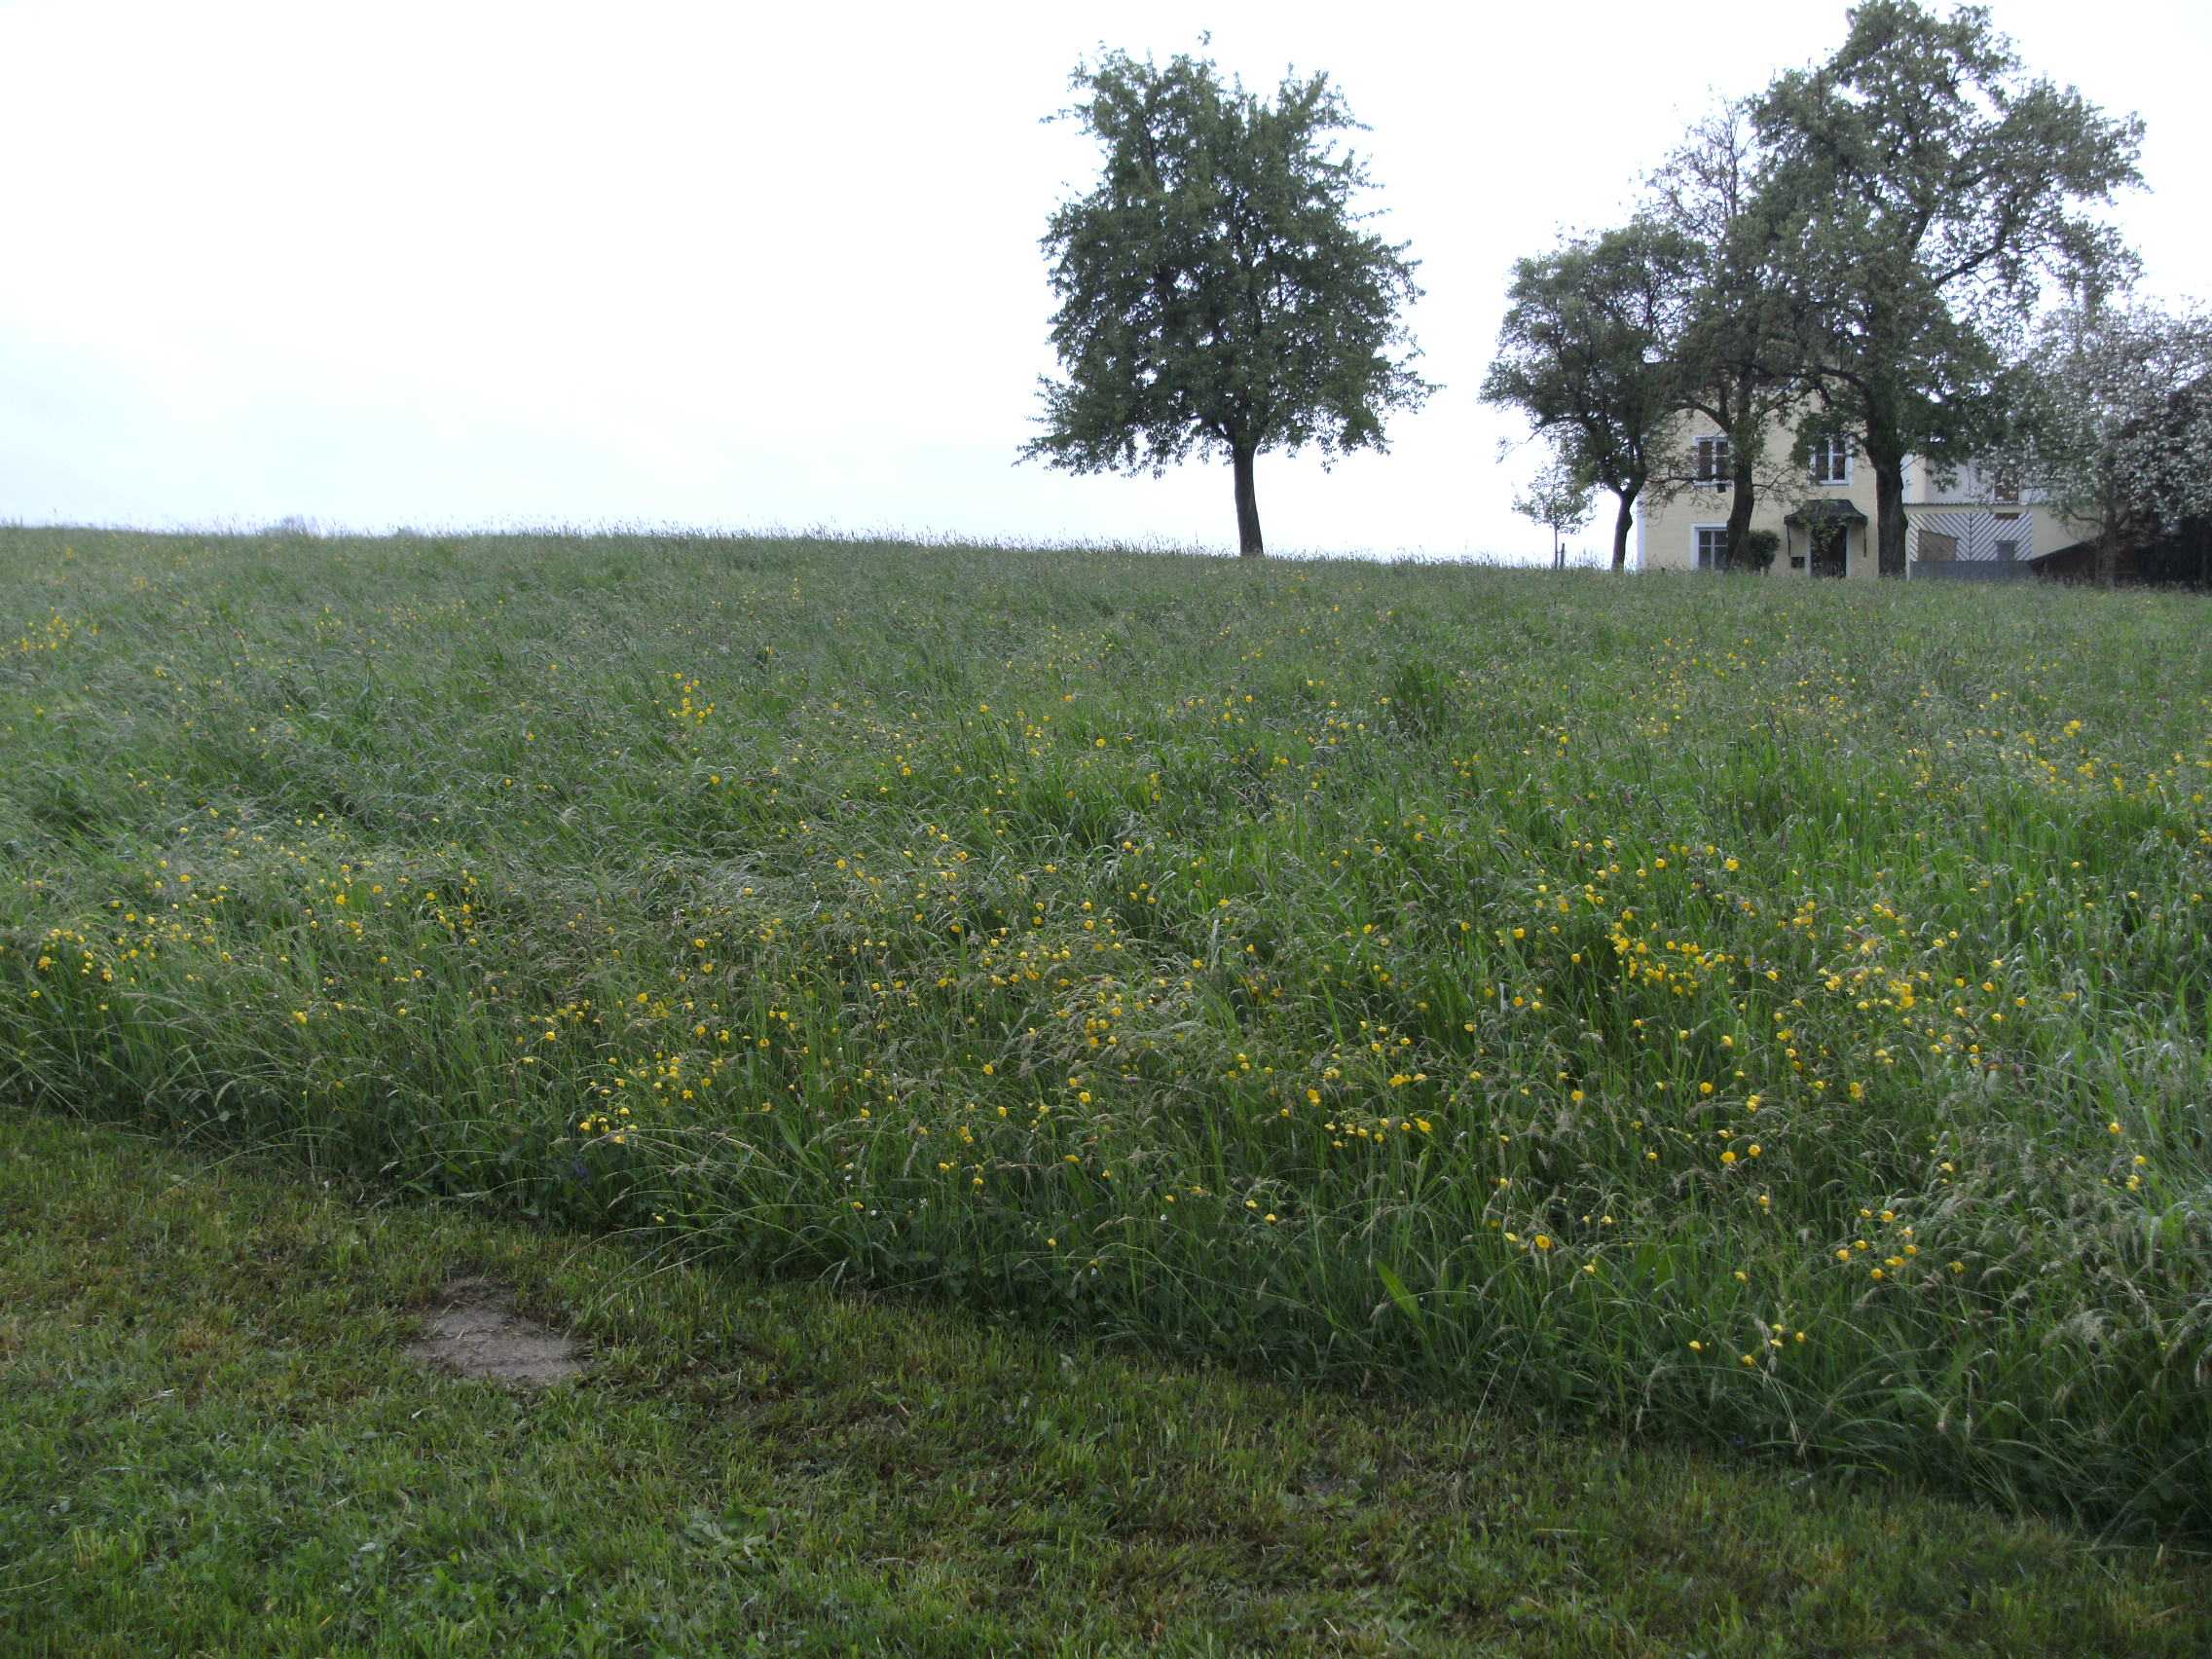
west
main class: Grassland
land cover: Grassland without tree/shrub cover
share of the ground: > 75 %
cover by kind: herbaceous plants 100 %
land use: Agriculture (excluding fallow land and kitchen gardens)
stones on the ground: < 10 %
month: May
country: AT
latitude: 48.2259
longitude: 13.3780
